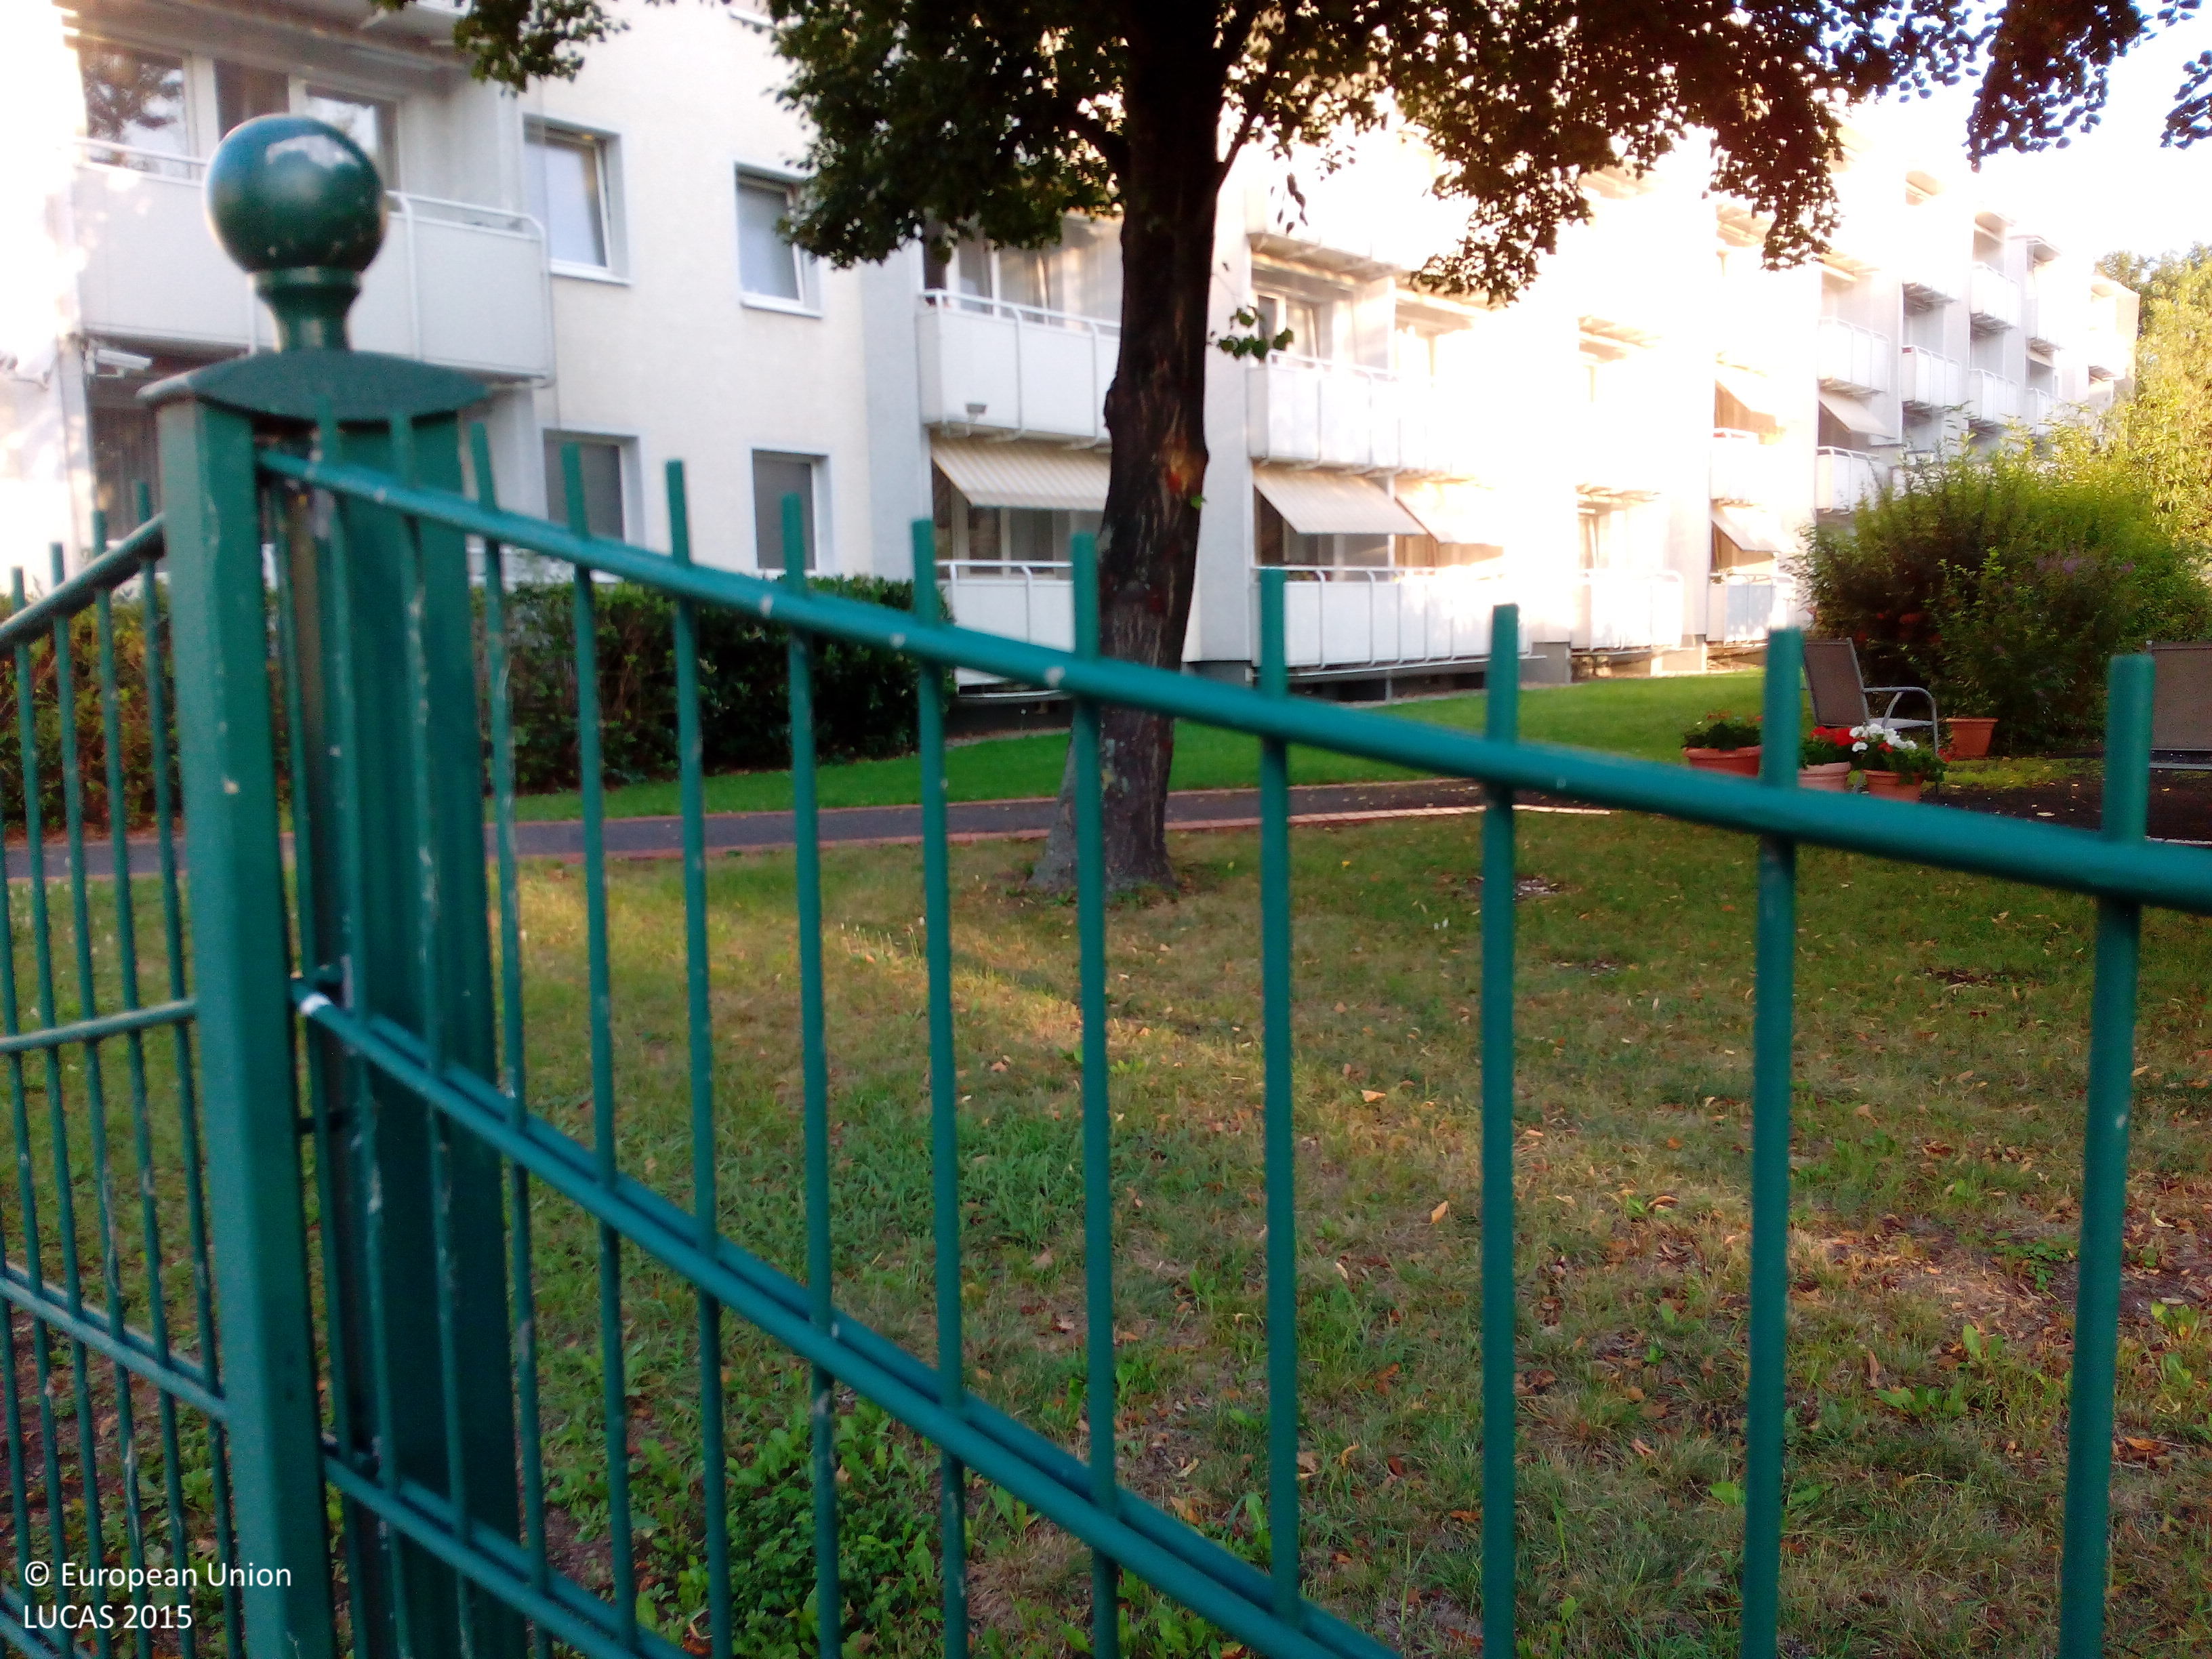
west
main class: Woodland
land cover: Broadleaved woodland
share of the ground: 25 - 50 %
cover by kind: herbaceous plants 45 %, broadleaved forest trees 40 %, consolidated bare surface 10 %, shrubs 5 %
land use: Residential
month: August
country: DE
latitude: 51.0069
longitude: 11.0116
